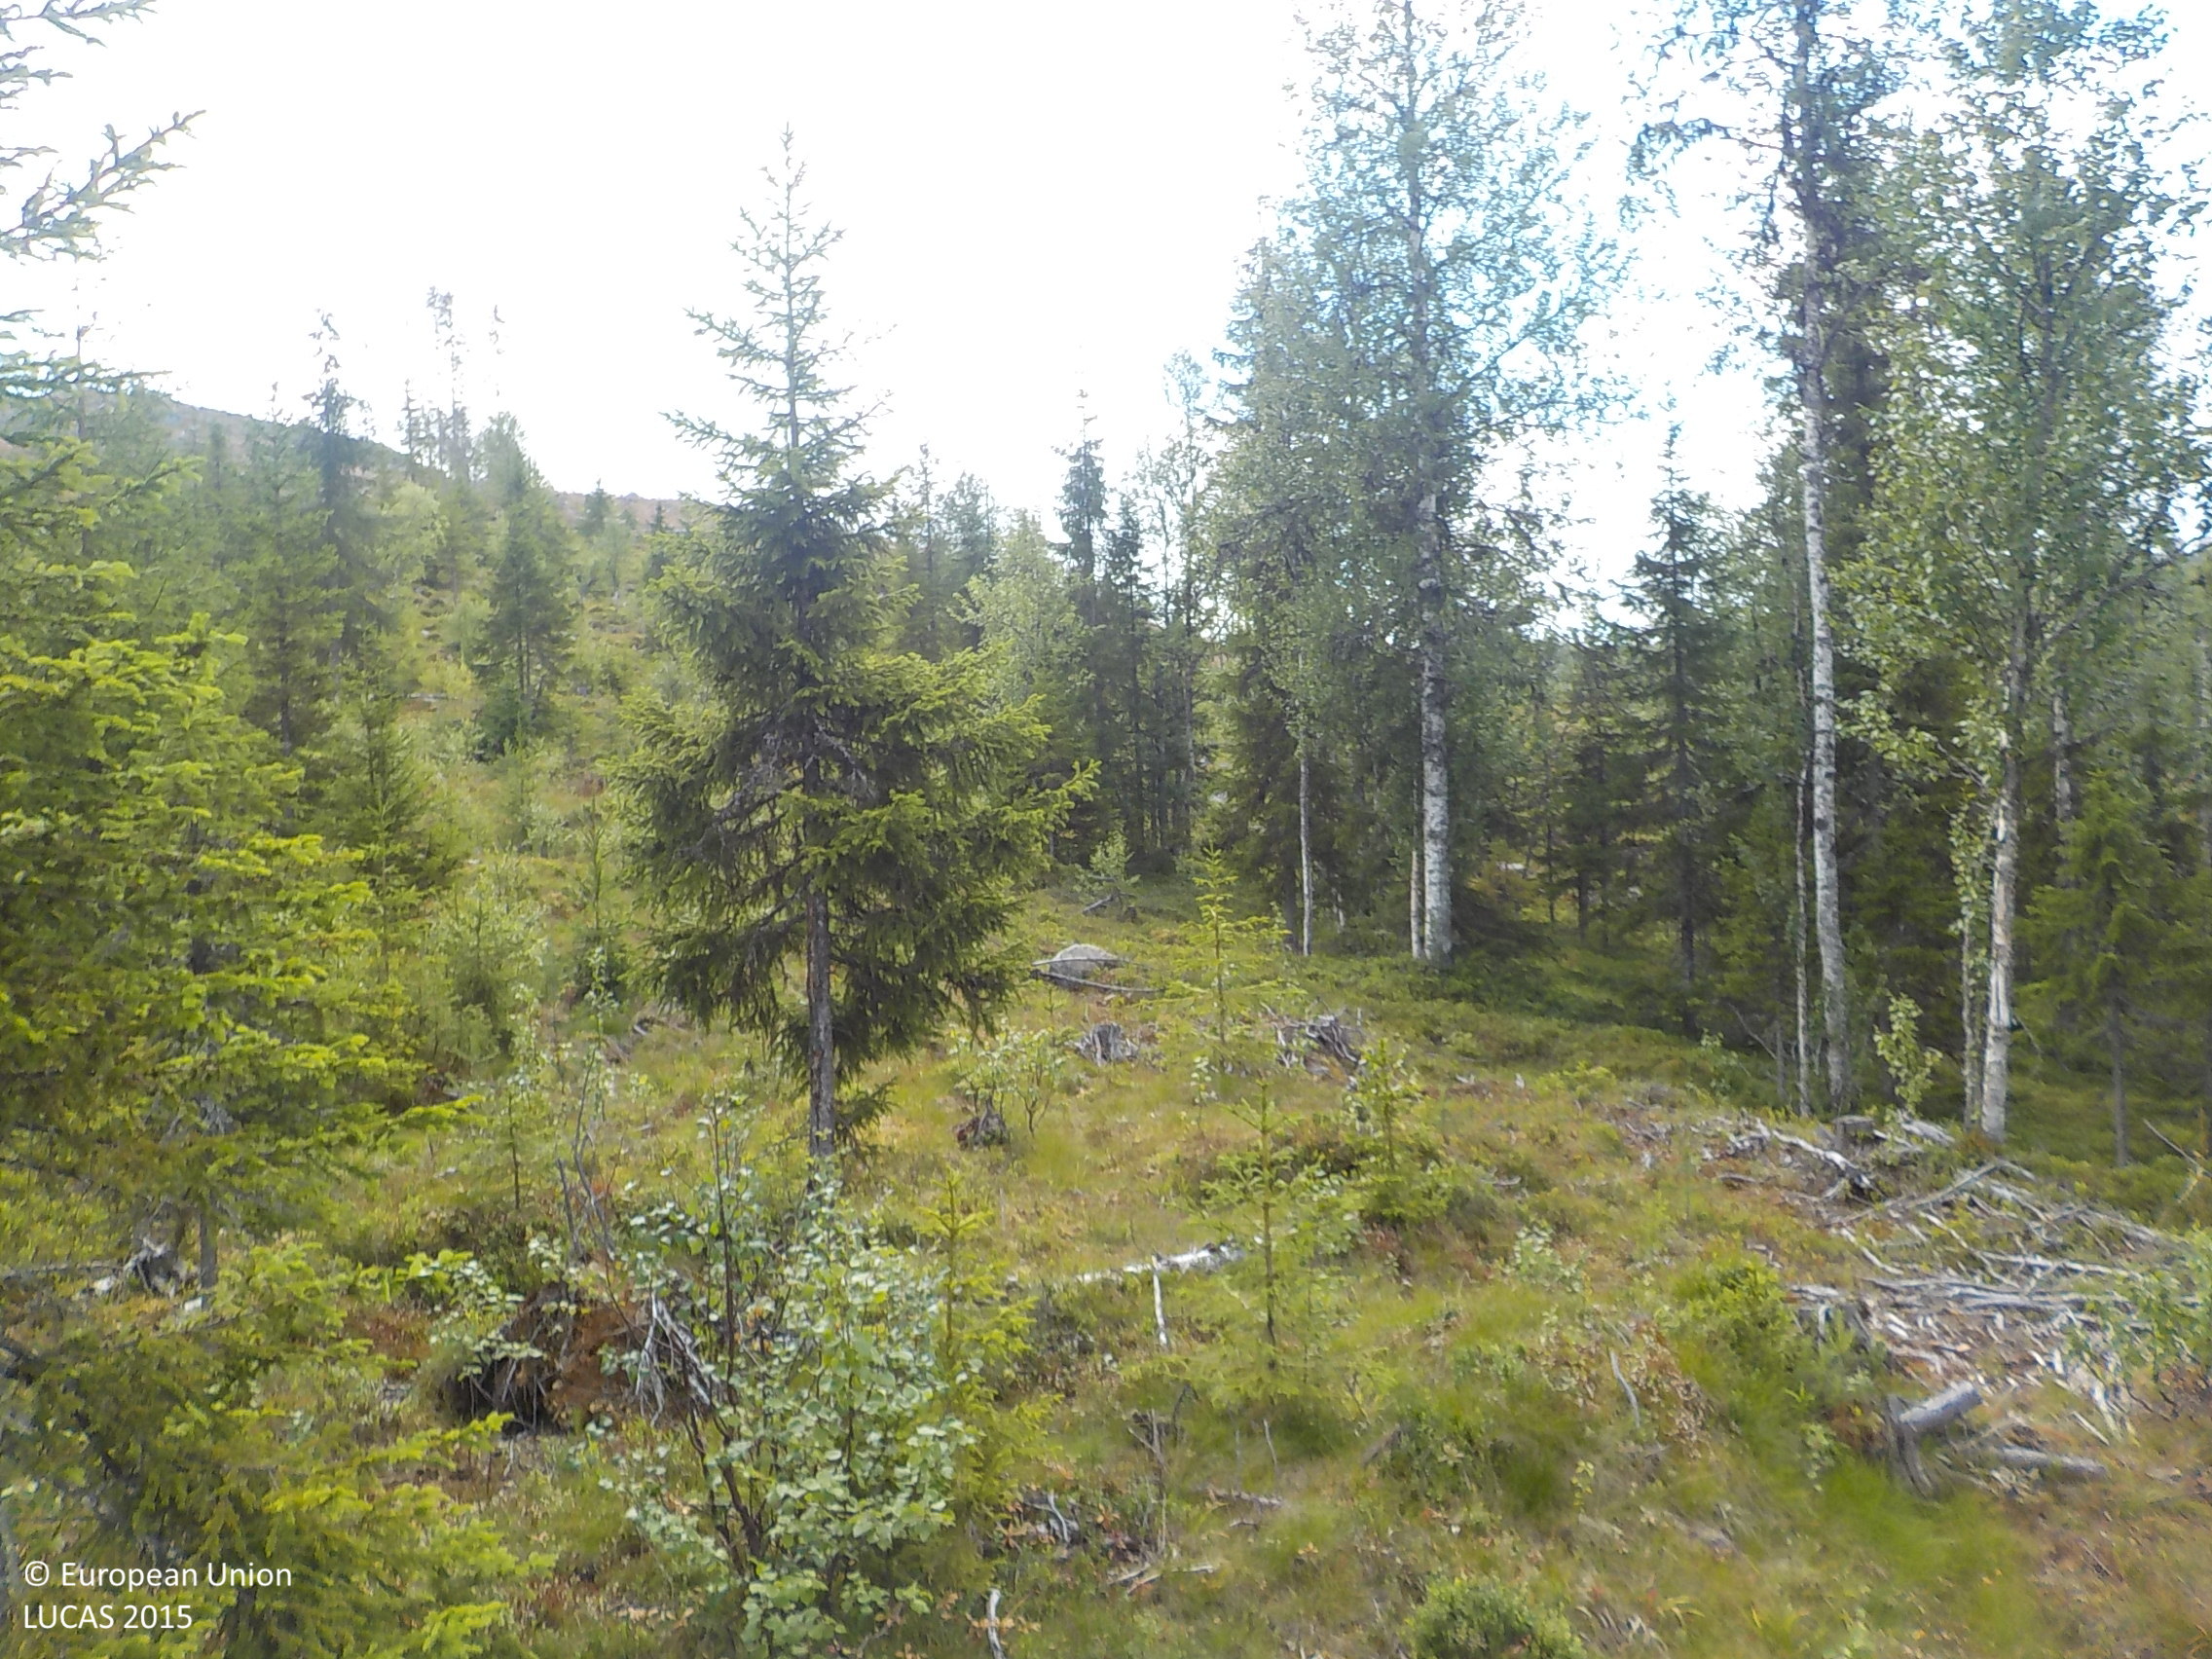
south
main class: Woodland
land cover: Spruce dominated mixed woodland
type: boreal forest
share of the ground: 25 - 50 %
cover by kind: herbaceous plants 60 %, coniferous forest trees 20 %, broadleaved forest trees 10 %, shrubs 5 %, lichens and mosses 5 %
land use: Forestry
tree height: < 5 m
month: August
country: SE
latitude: 64.1238
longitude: 17.6301
